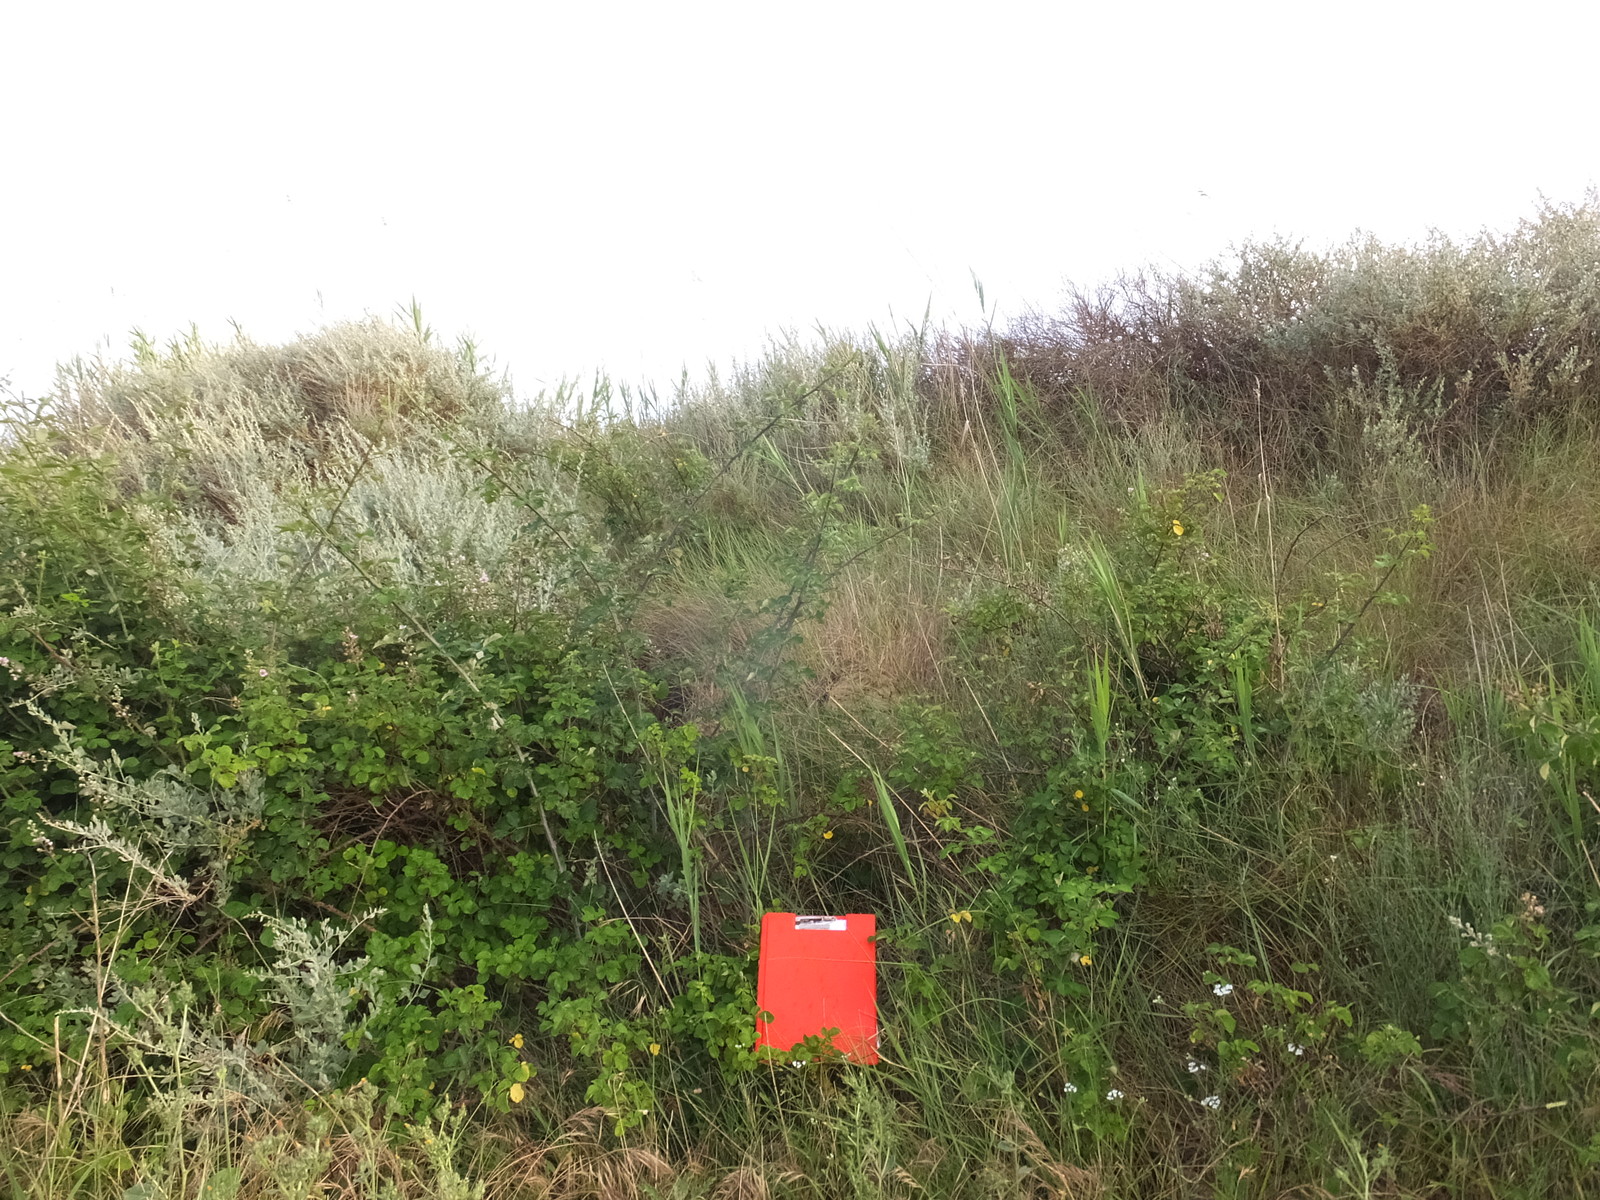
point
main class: Grassland
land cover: Grassland with sparse tree/shrub cover
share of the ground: > 75 %
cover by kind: herbaceous plants 85 %, shrubs 10 %, broadleaved forest trees 5 %
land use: Semi-natural and natural areas not in use
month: June
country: ES
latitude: 41.6899
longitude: 0.0480
